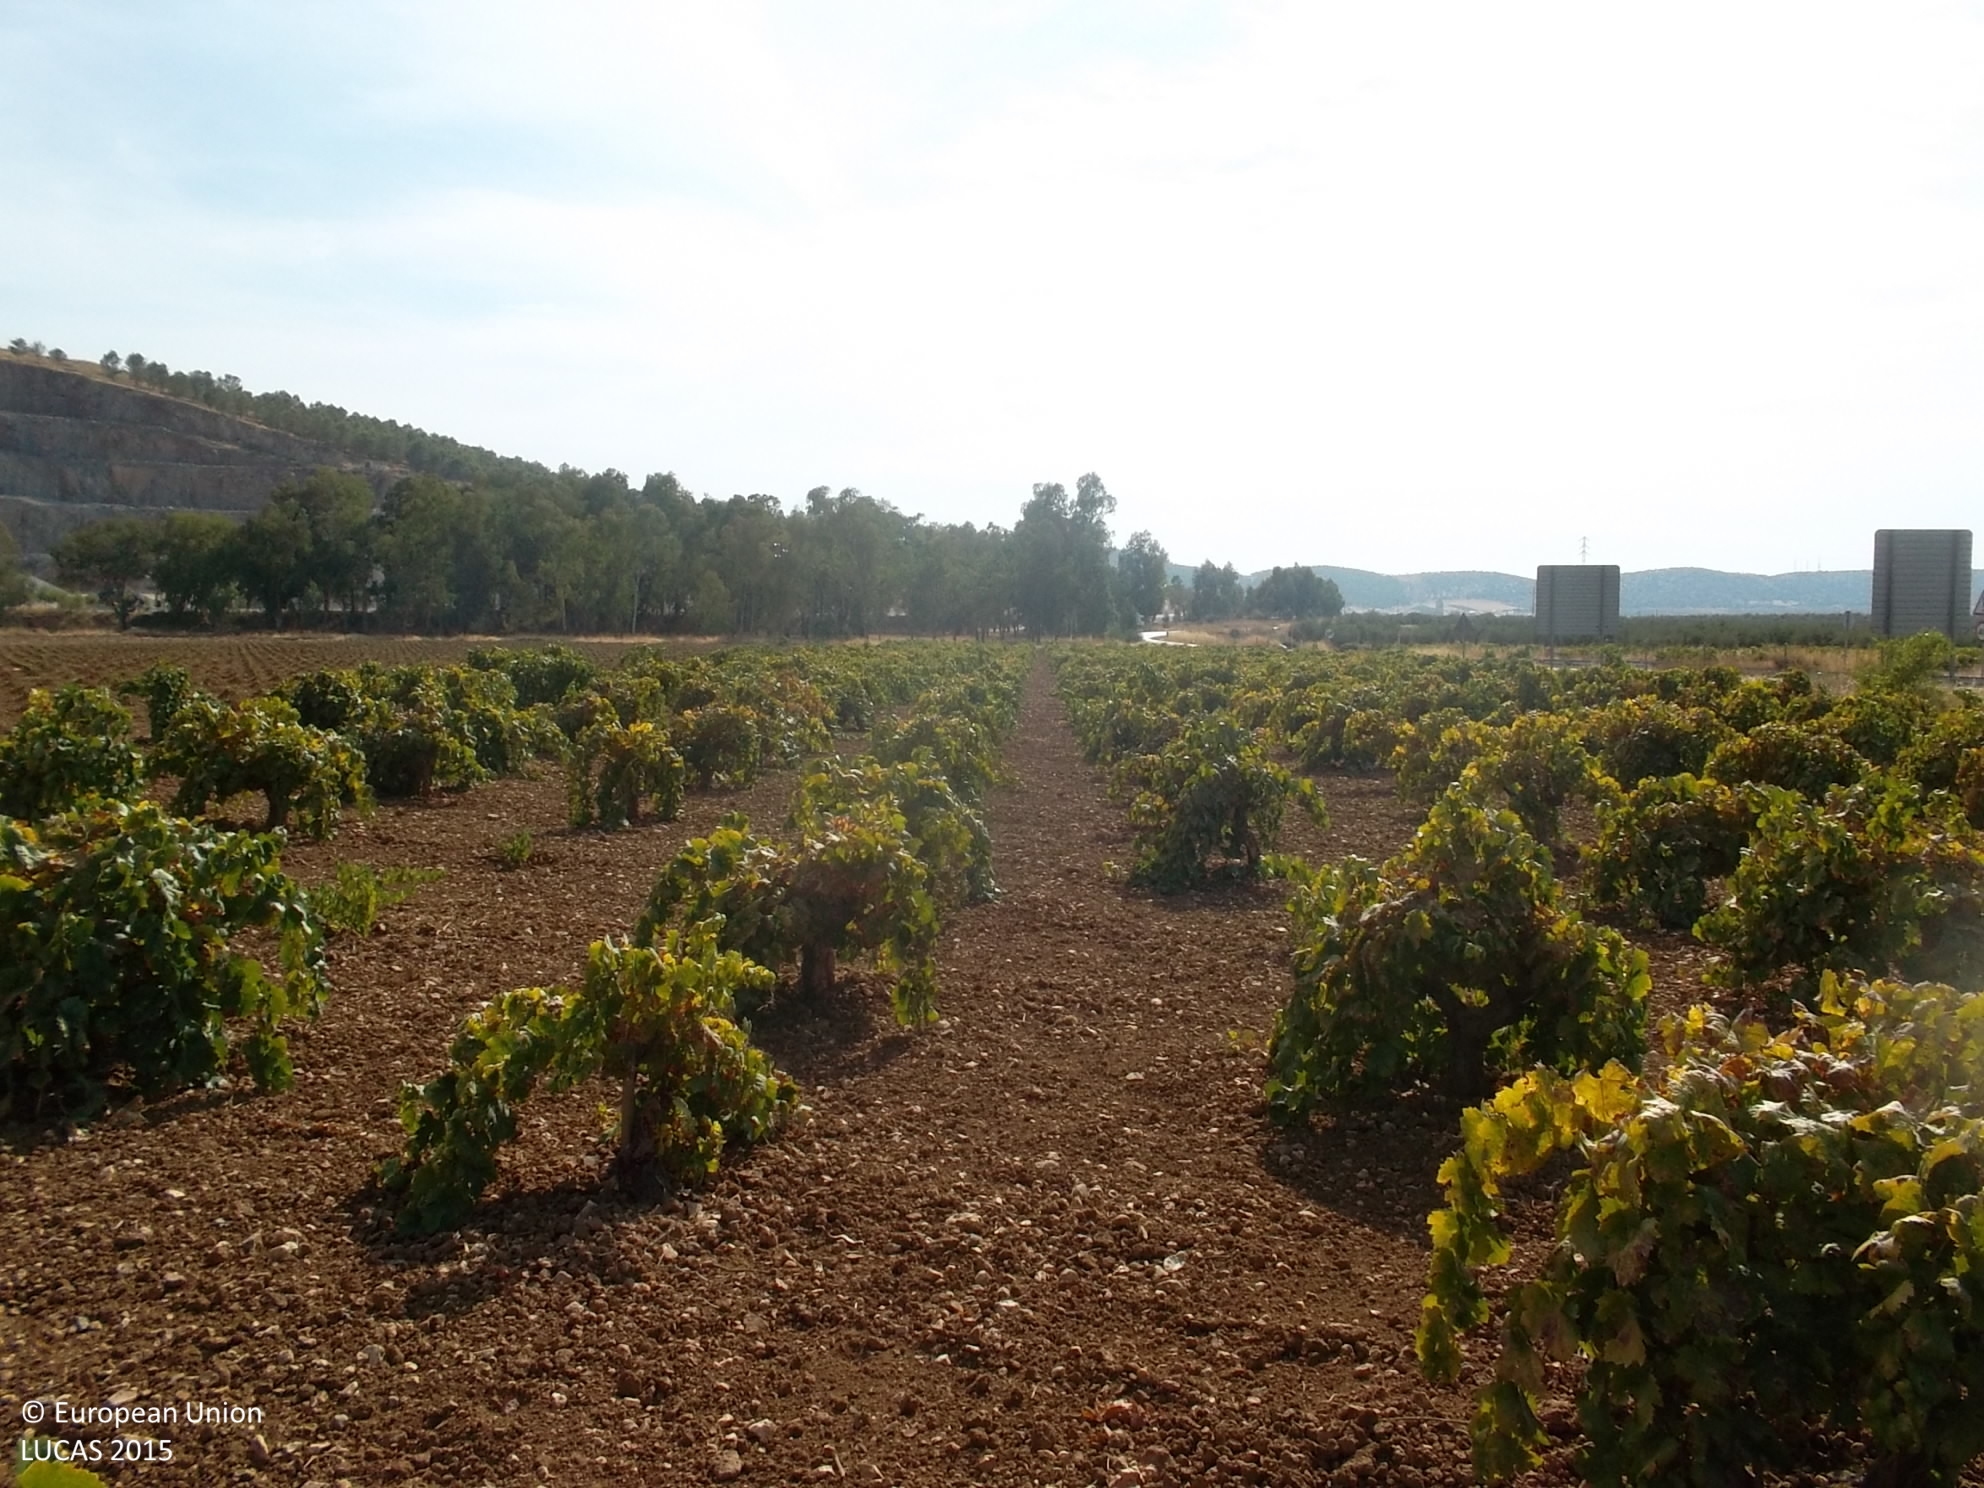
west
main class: Cropland
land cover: Vineyards
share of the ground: 10 - 25 %
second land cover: Other bare soil
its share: > 75 %
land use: Agriculture (excluding fallow land and kitchen gardens)
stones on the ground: < 10 %
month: September
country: ES
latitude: 38.4602
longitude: -6.3575
